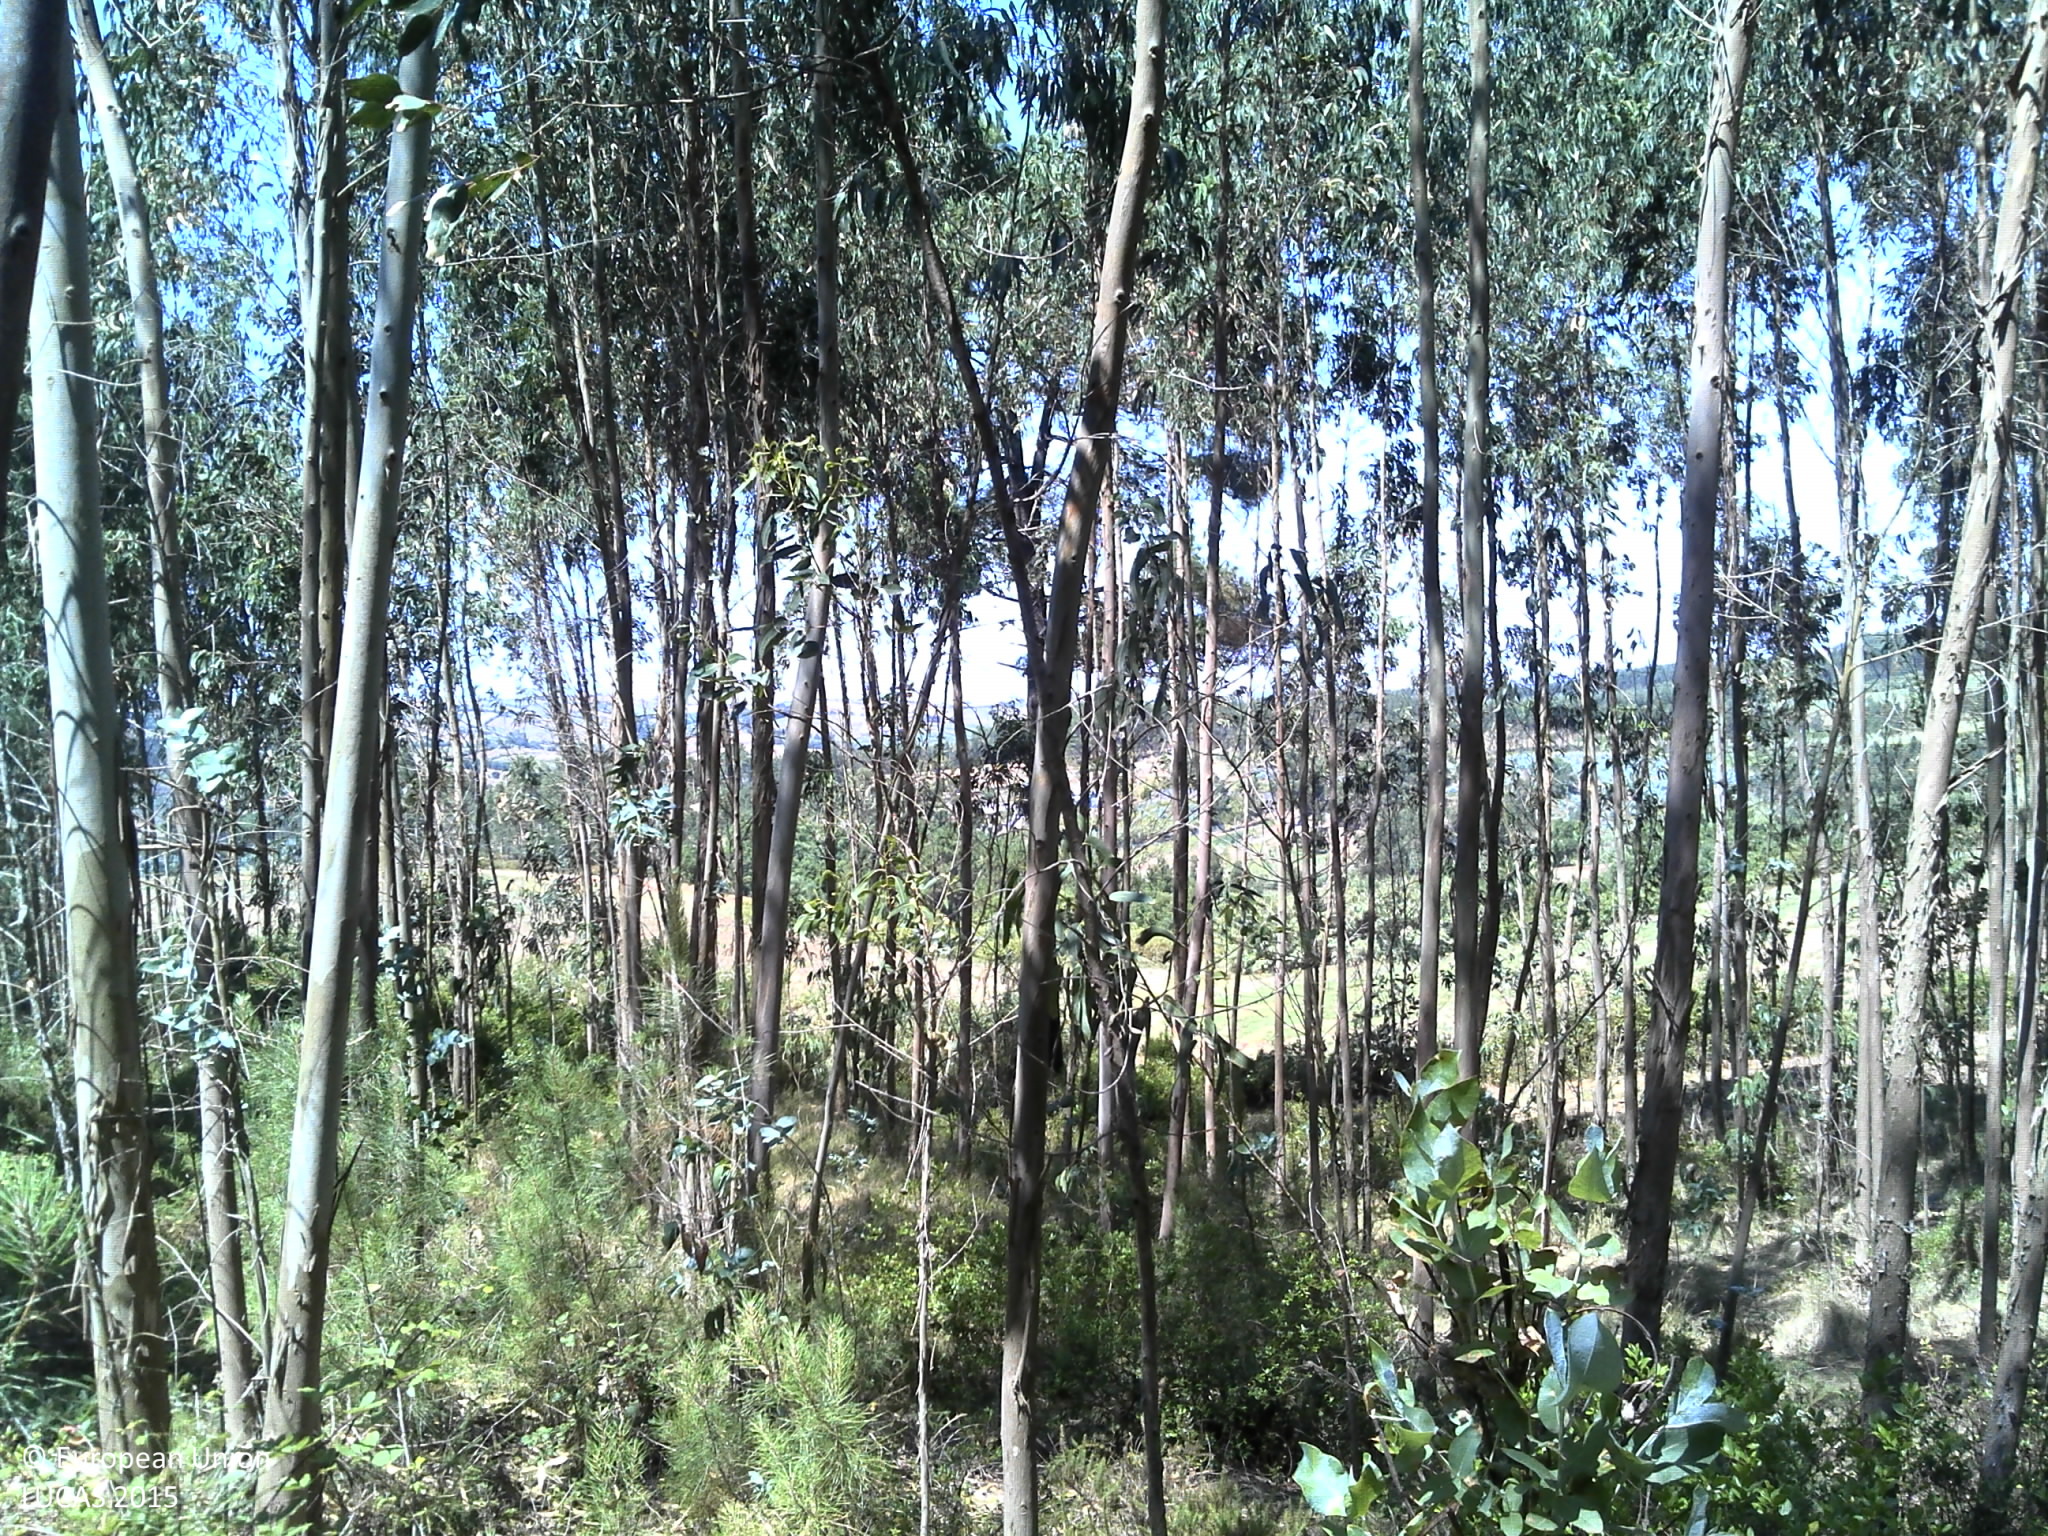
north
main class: Woodland
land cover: Broadleaved woodland
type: exotic forest
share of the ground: 50 - 75 %
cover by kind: broadleaved forest trees 70 %, shrubs 20 %, unconsolidated bare surface 10 %
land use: Forestry
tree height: > 5 m
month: June
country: PT
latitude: 39.1841
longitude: -9.2951
